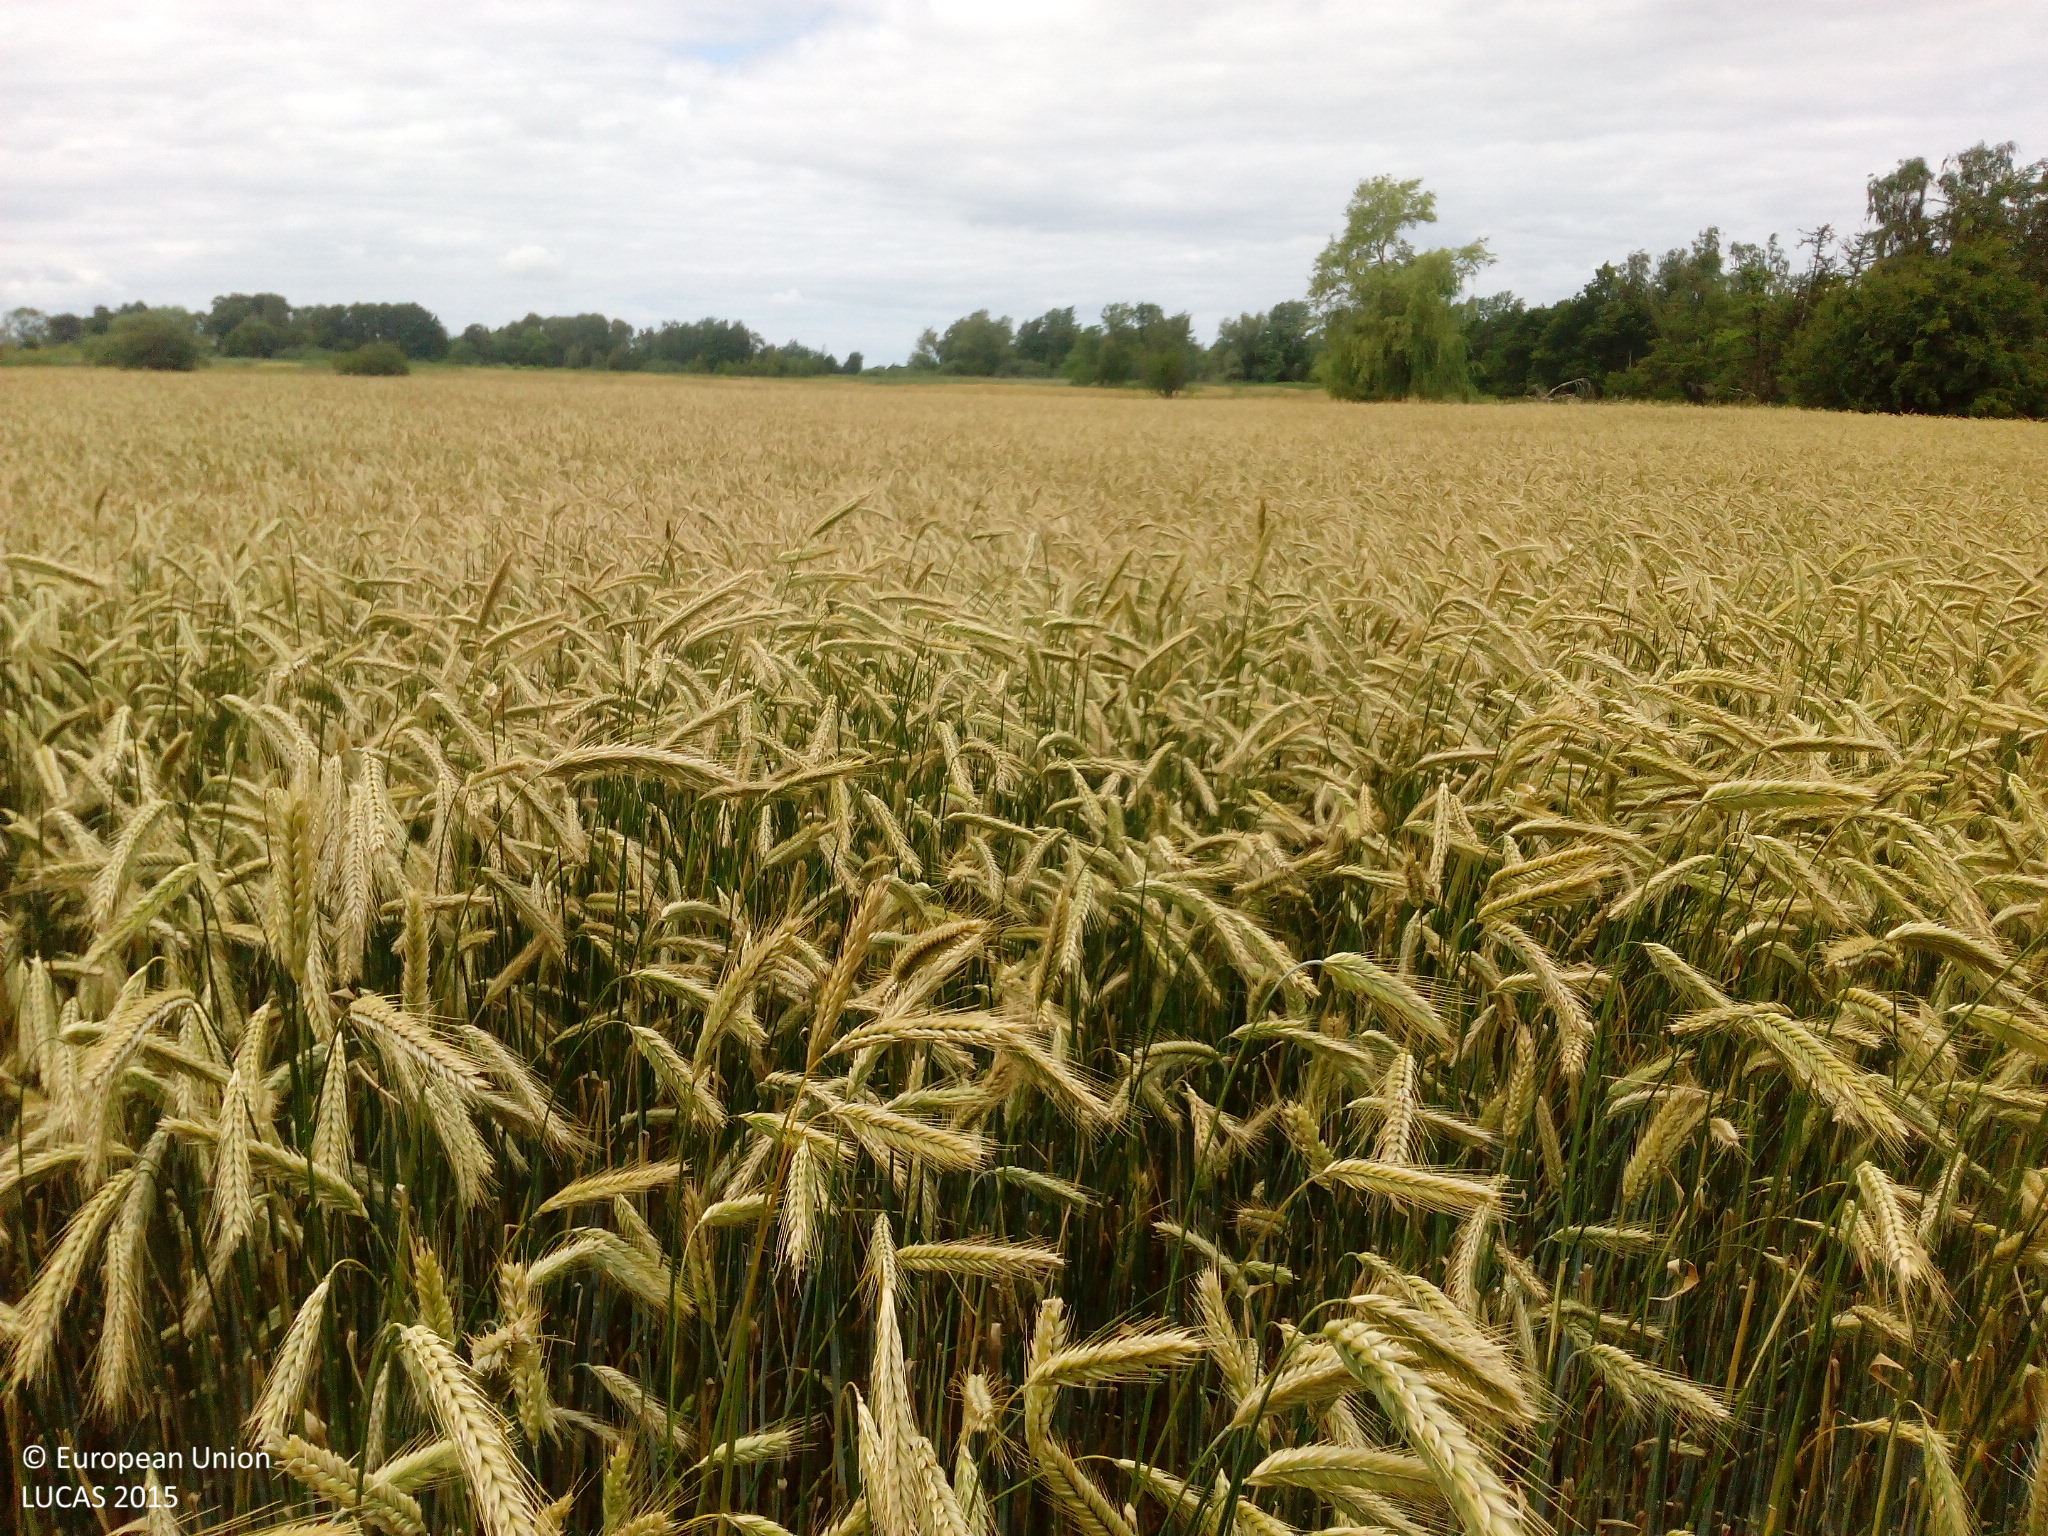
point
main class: Cropland
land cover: Rye
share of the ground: > 75 %
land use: Agriculture (excluding fallow land and kitchen gardens)
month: July
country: DK
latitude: 55.9712
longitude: 12.1930
